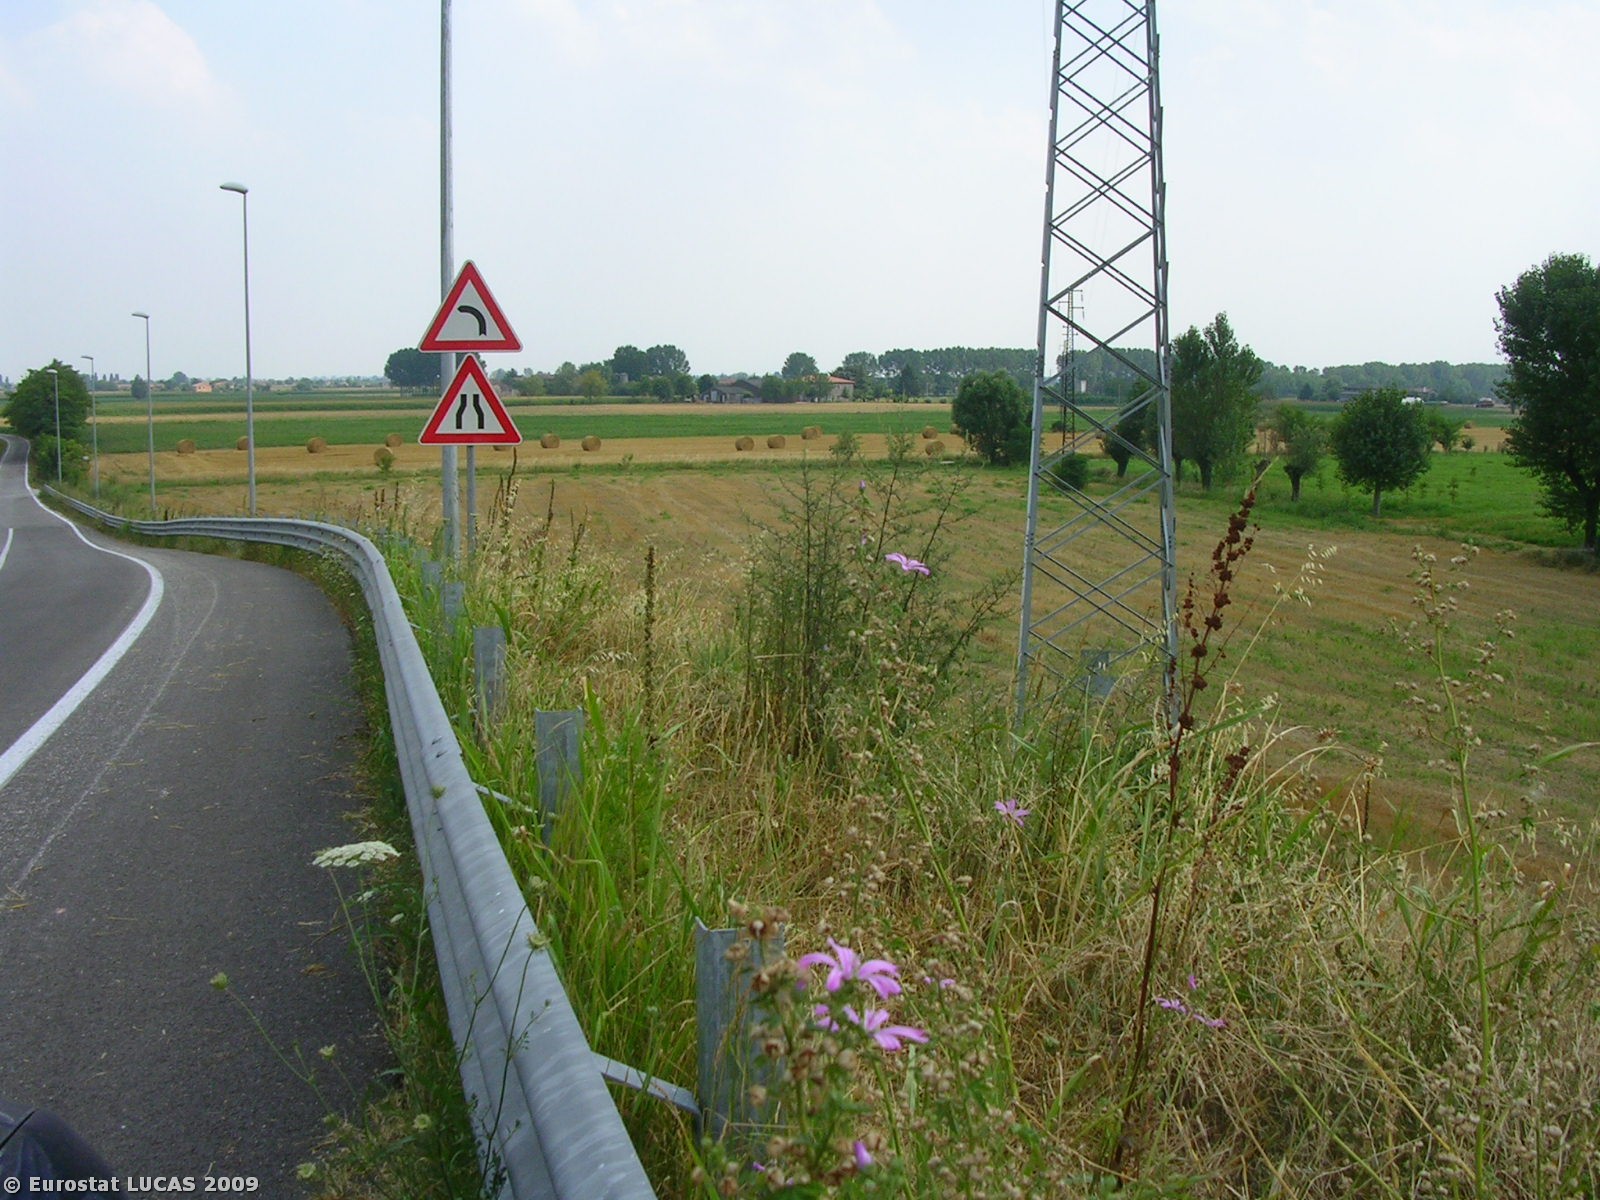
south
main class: Cropland
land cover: Common wheat
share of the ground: > 75 %
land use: Agriculture (excluding fallow land and kitchen gardens)
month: July
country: IT
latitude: 45.2028
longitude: 11.6648
